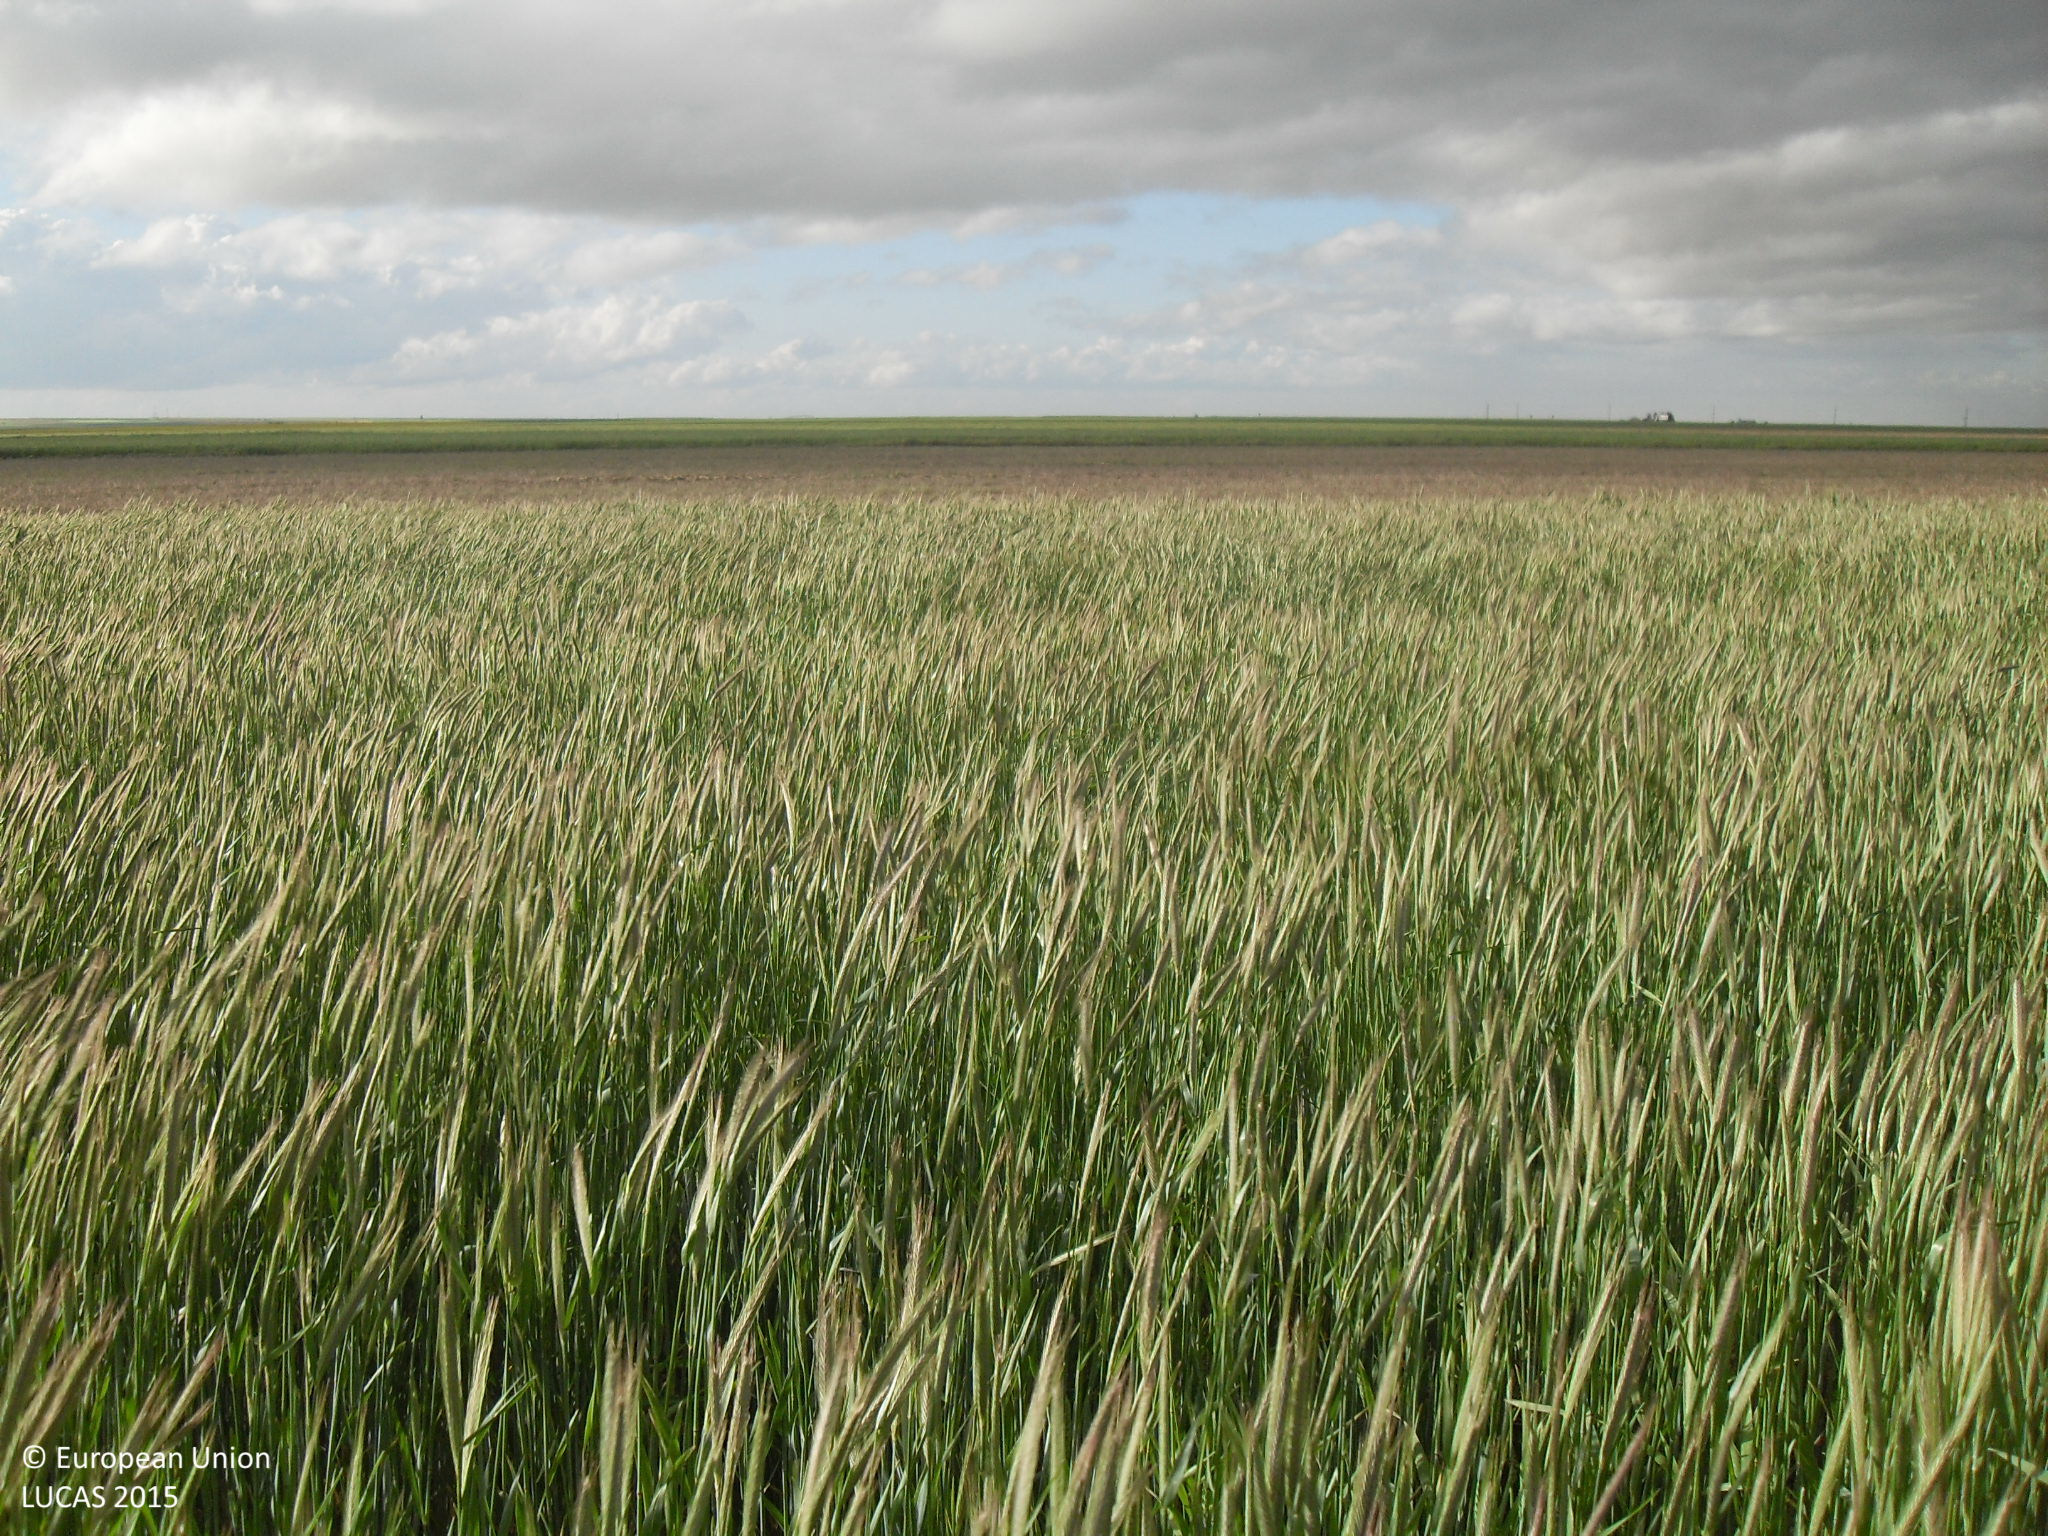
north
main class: Cropland
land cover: Rye
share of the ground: > 75 %
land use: Agriculture (excluding fallow land and kitchen gardens)
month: May
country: ES
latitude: 40.9922
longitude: -5.2738
